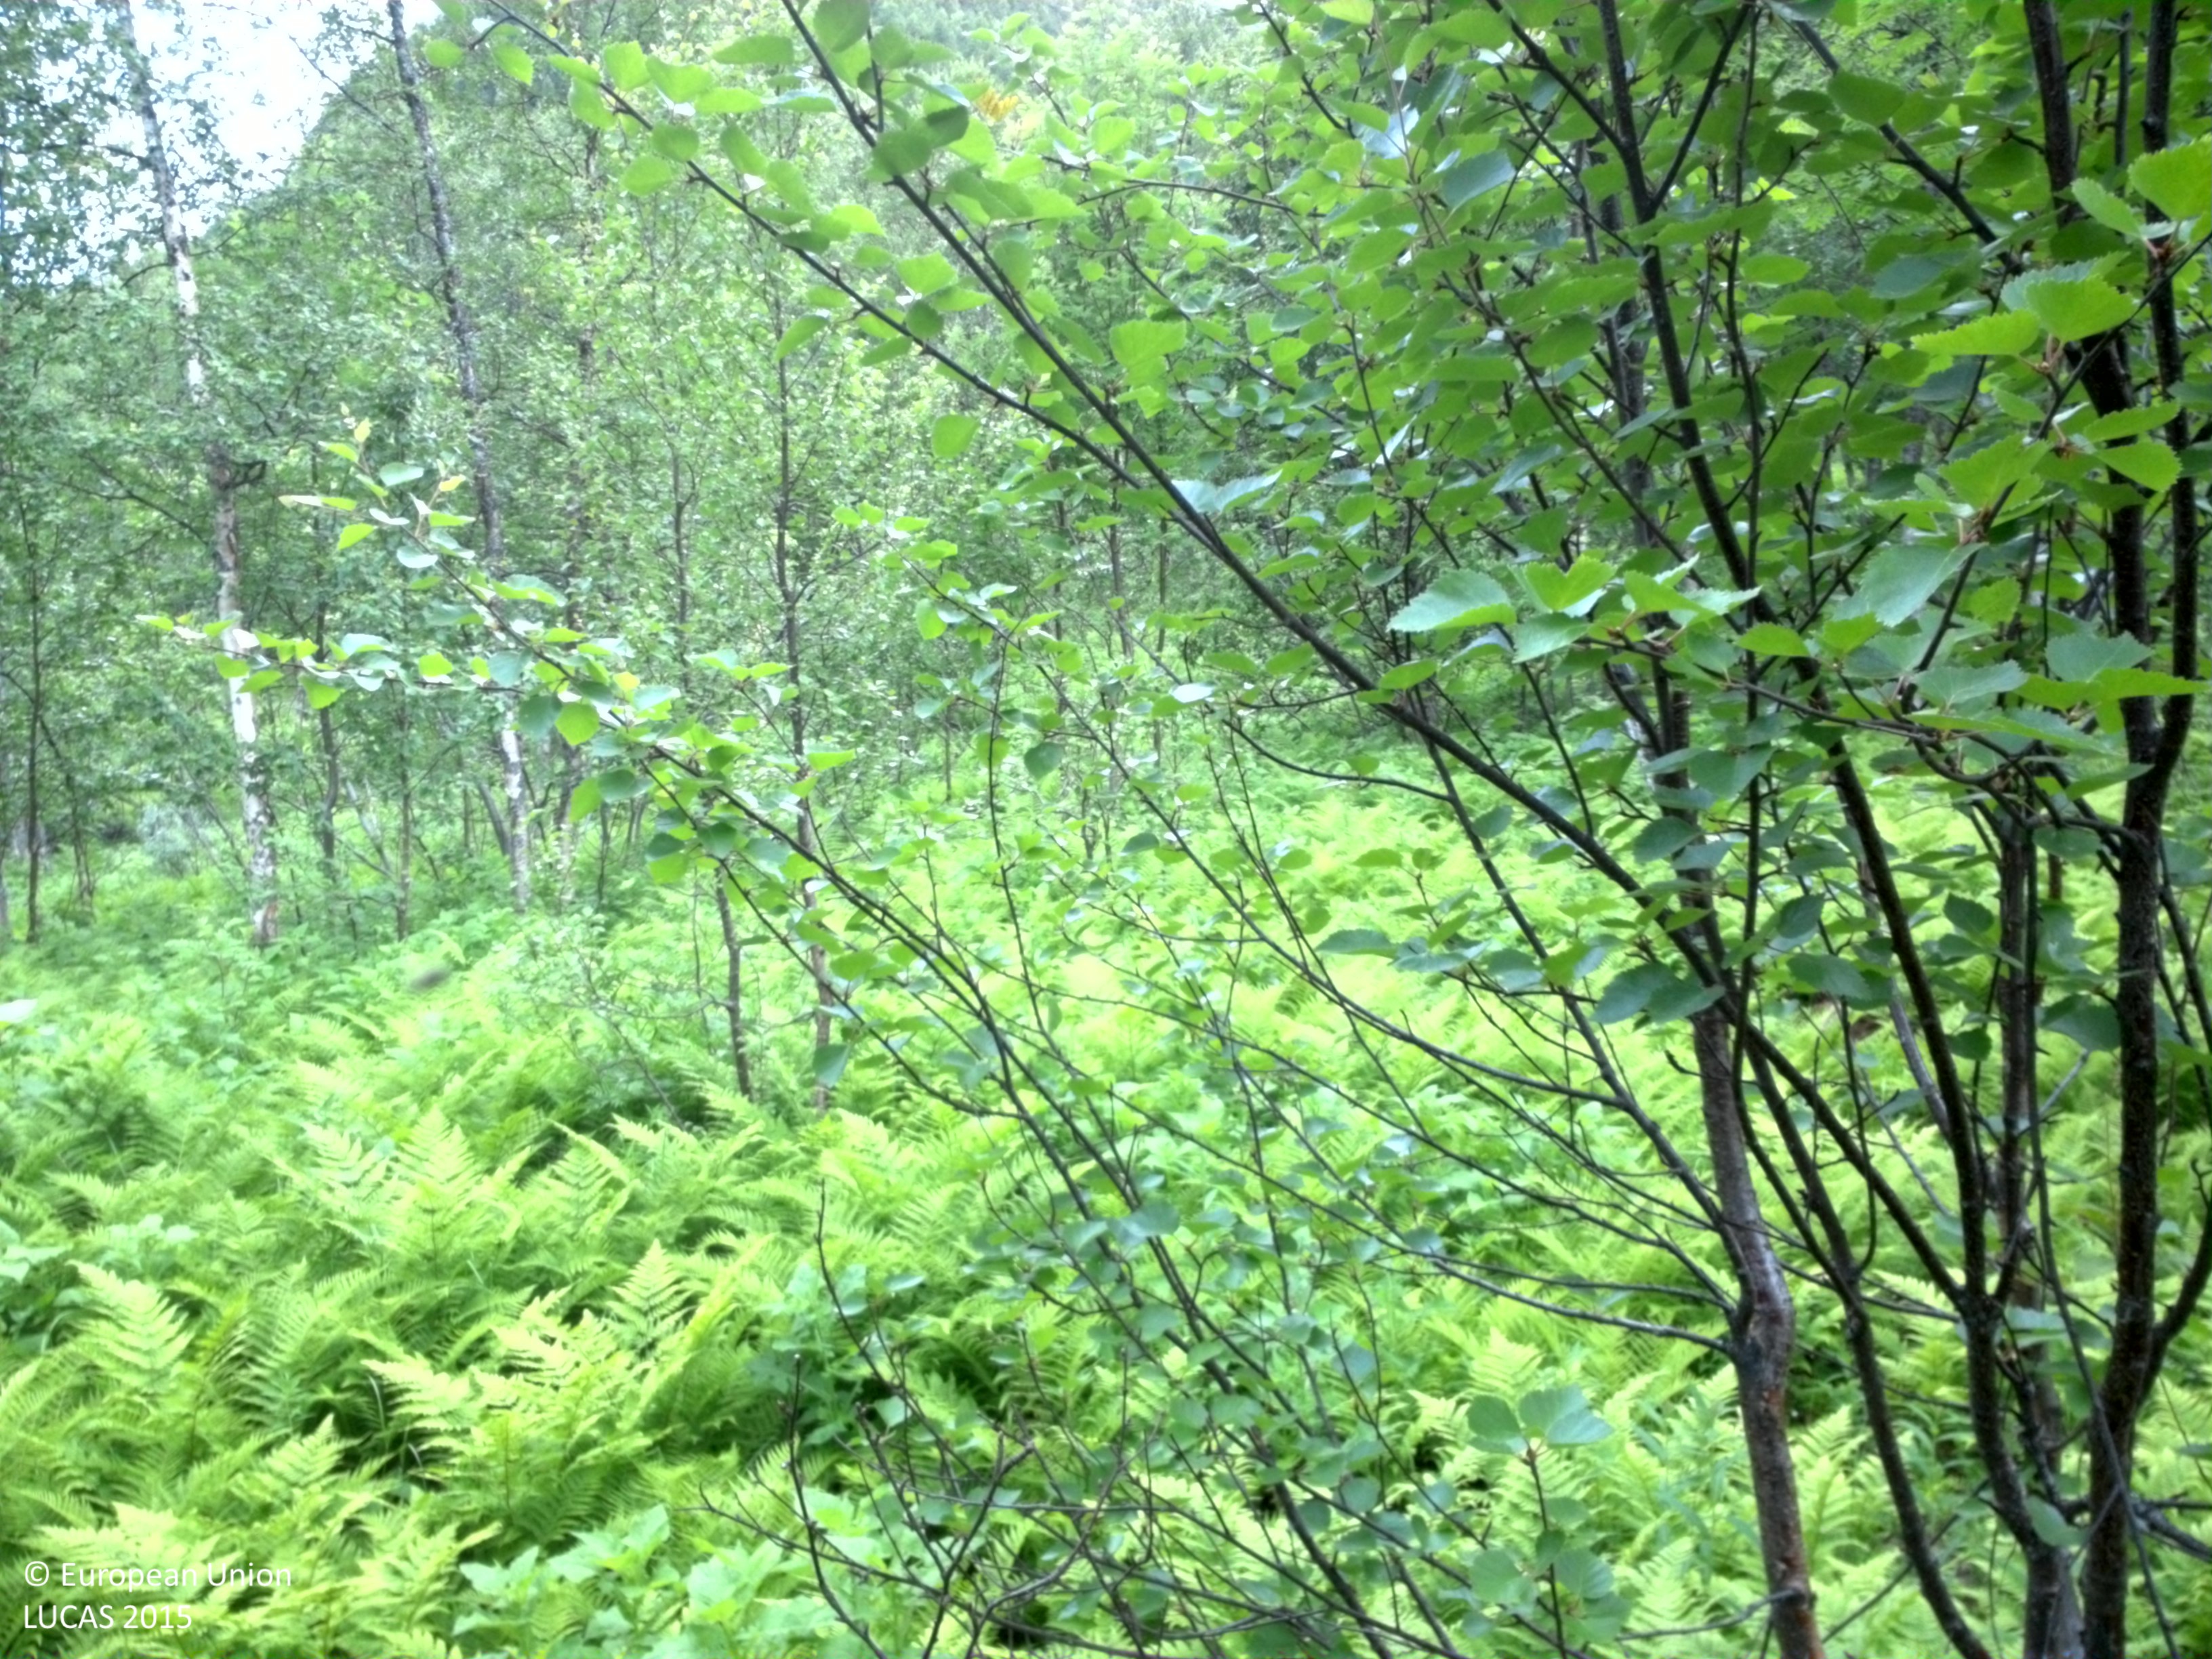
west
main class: Woodland
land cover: Broadleaved woodland
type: non-riverine alder, birch or aspen forest
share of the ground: 25 - 50 %
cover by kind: herbaceous plants 60 %, broadleaved forest trees 35 %, shrubs 5 %
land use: Amenities, museums, leisure
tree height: > 5 m
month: July
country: SE
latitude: 65.6718
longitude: 15.7277
